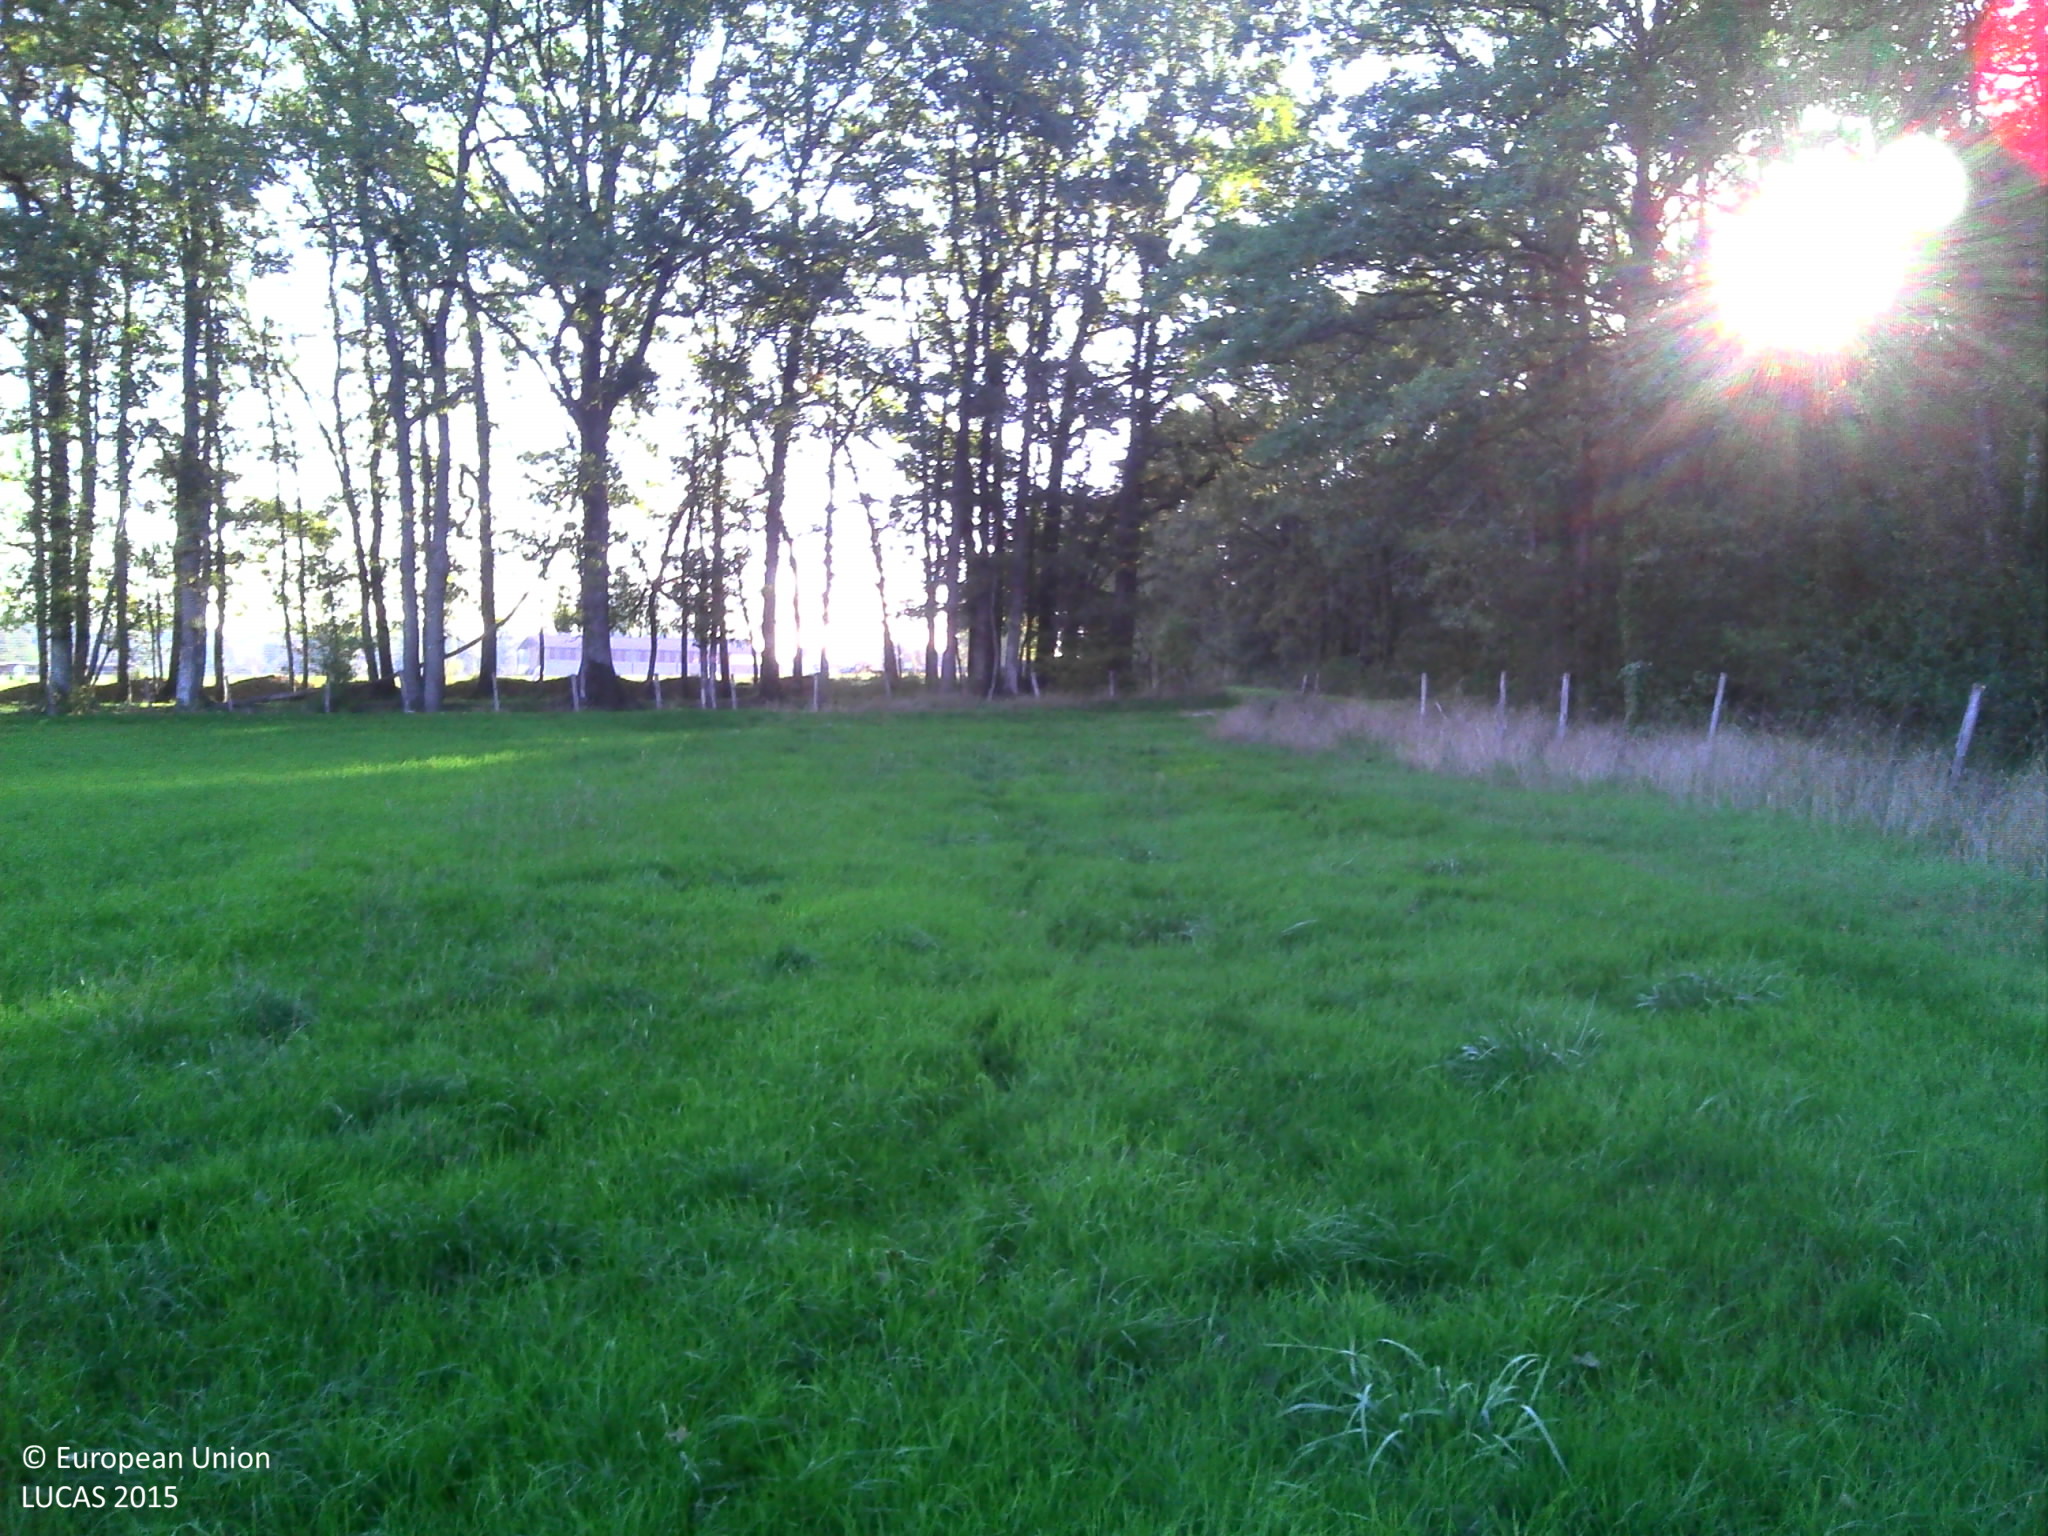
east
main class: Grassland
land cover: Grassland without tree/shrub cover
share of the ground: > 75 %
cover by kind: herbaceous plants 100 %
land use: Agriculture (excluding fallow land and kitchen gardens)
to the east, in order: Grassland without tree/shrub cover; Fences; Ditches and canals; Broadleaved woodland; Grassland without tree/shrub cover; Fences; Grass margins; Tracks; Grass margins; Lines of trees; Shrubland with sparse tree cover; Railways
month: October
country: FR
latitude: 48.0362
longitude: 3.8938
